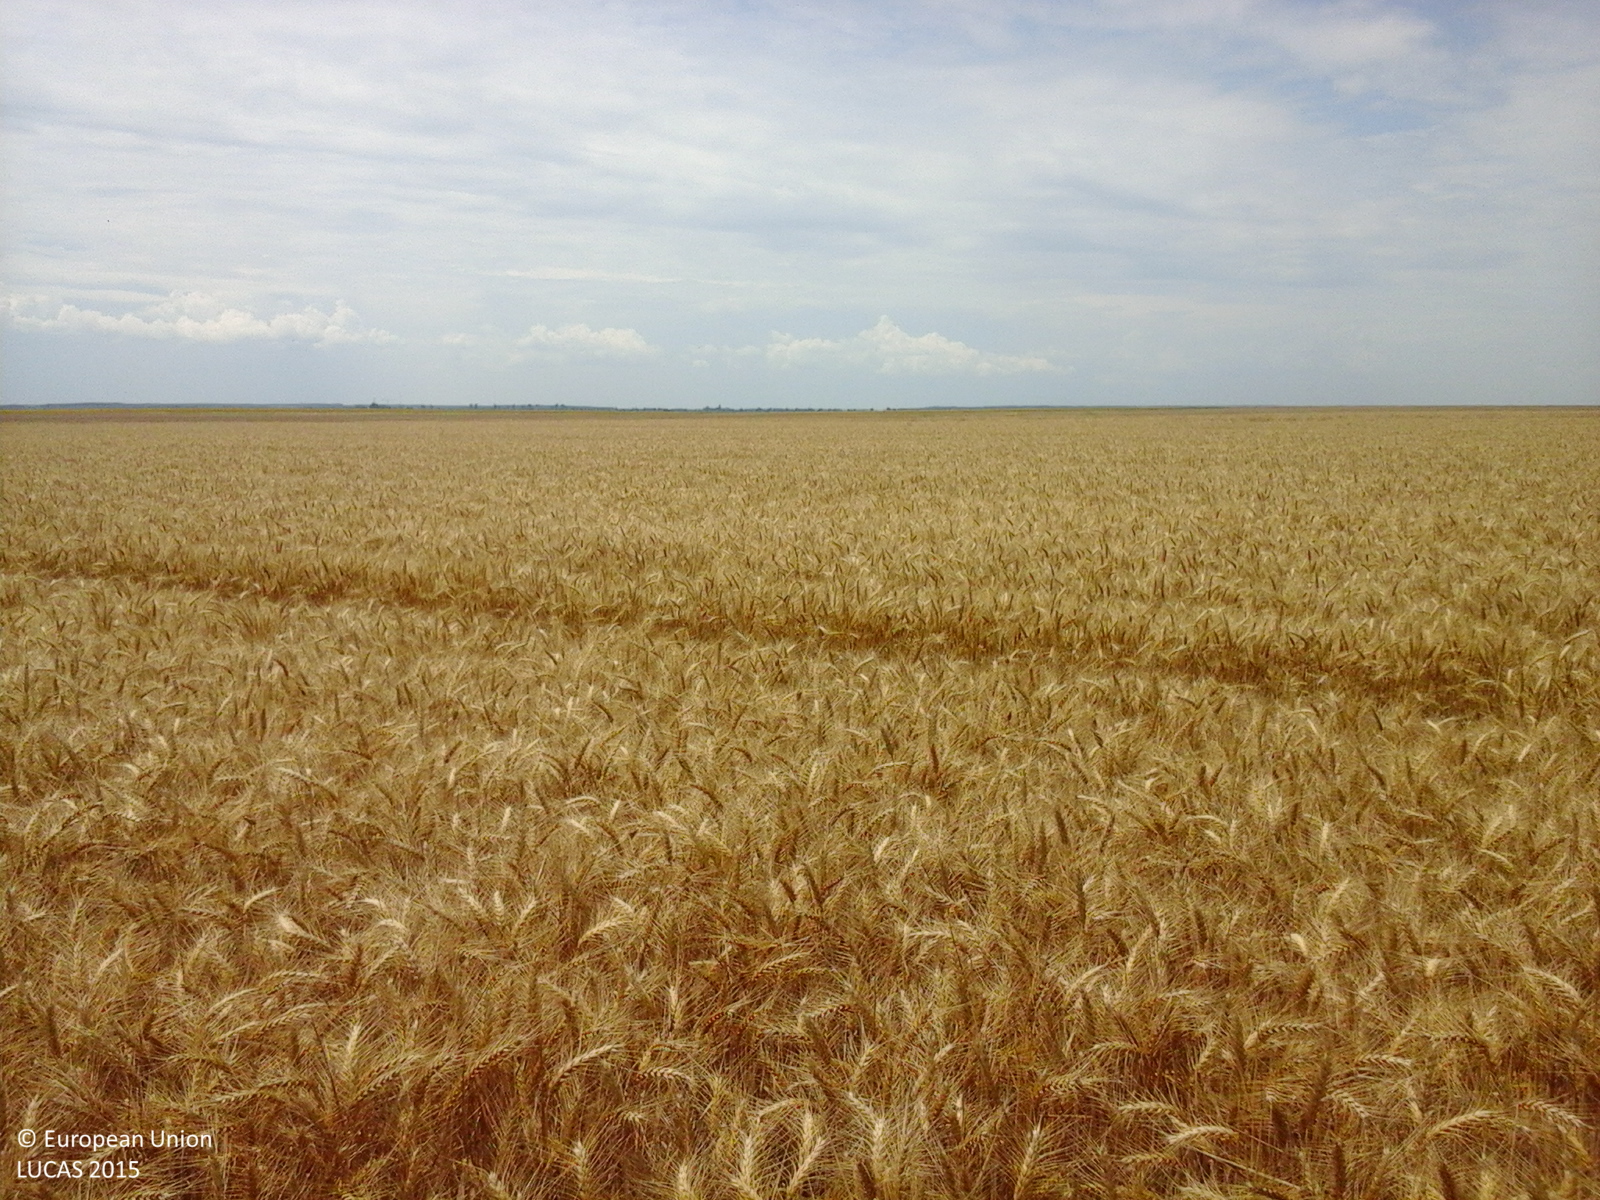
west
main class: Cropland
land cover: Common wheat
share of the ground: > 75 %
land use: Agriculture (excluding fallow land and kitchen gardens)
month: June
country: RO
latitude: 44.2353
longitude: 26.0145
